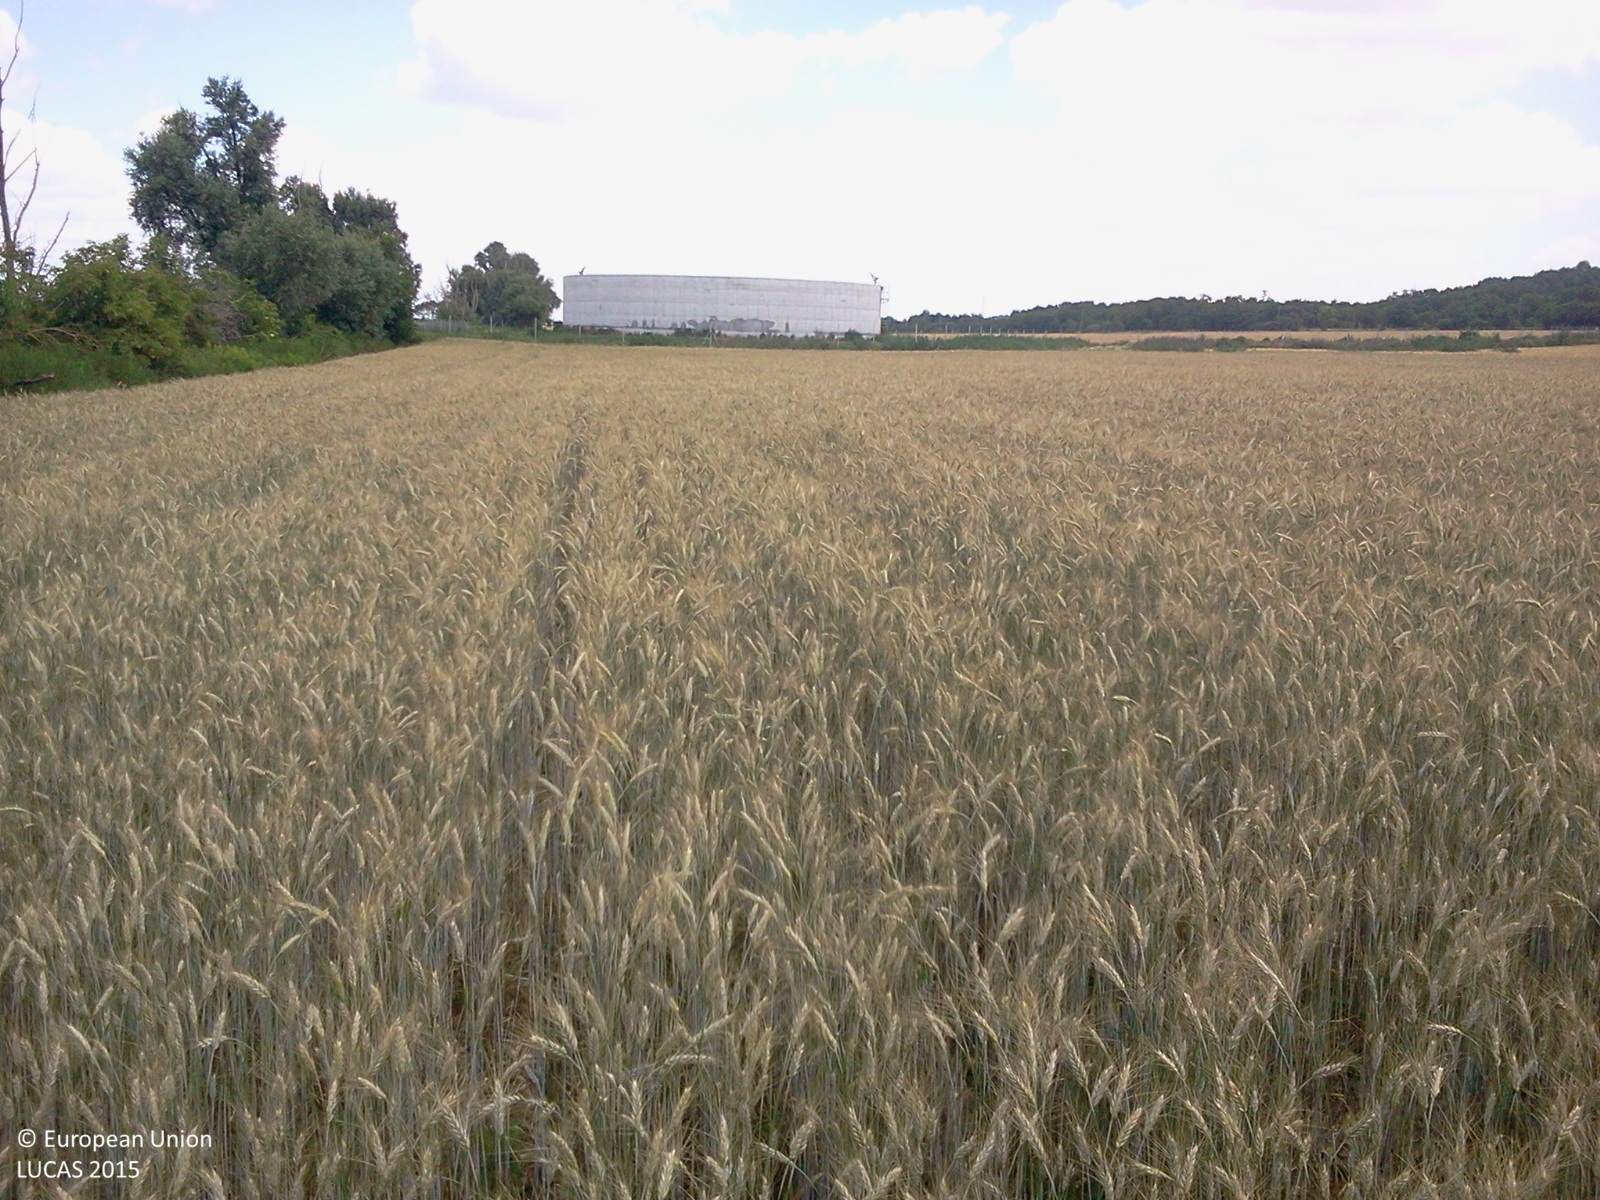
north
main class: Cropland
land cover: Durum wheat
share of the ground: > 75 %
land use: Agriculture (excluding fallow land and kitchen gardens)
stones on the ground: < 10 %
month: June
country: HU
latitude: 46.9637
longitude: 17.1147
